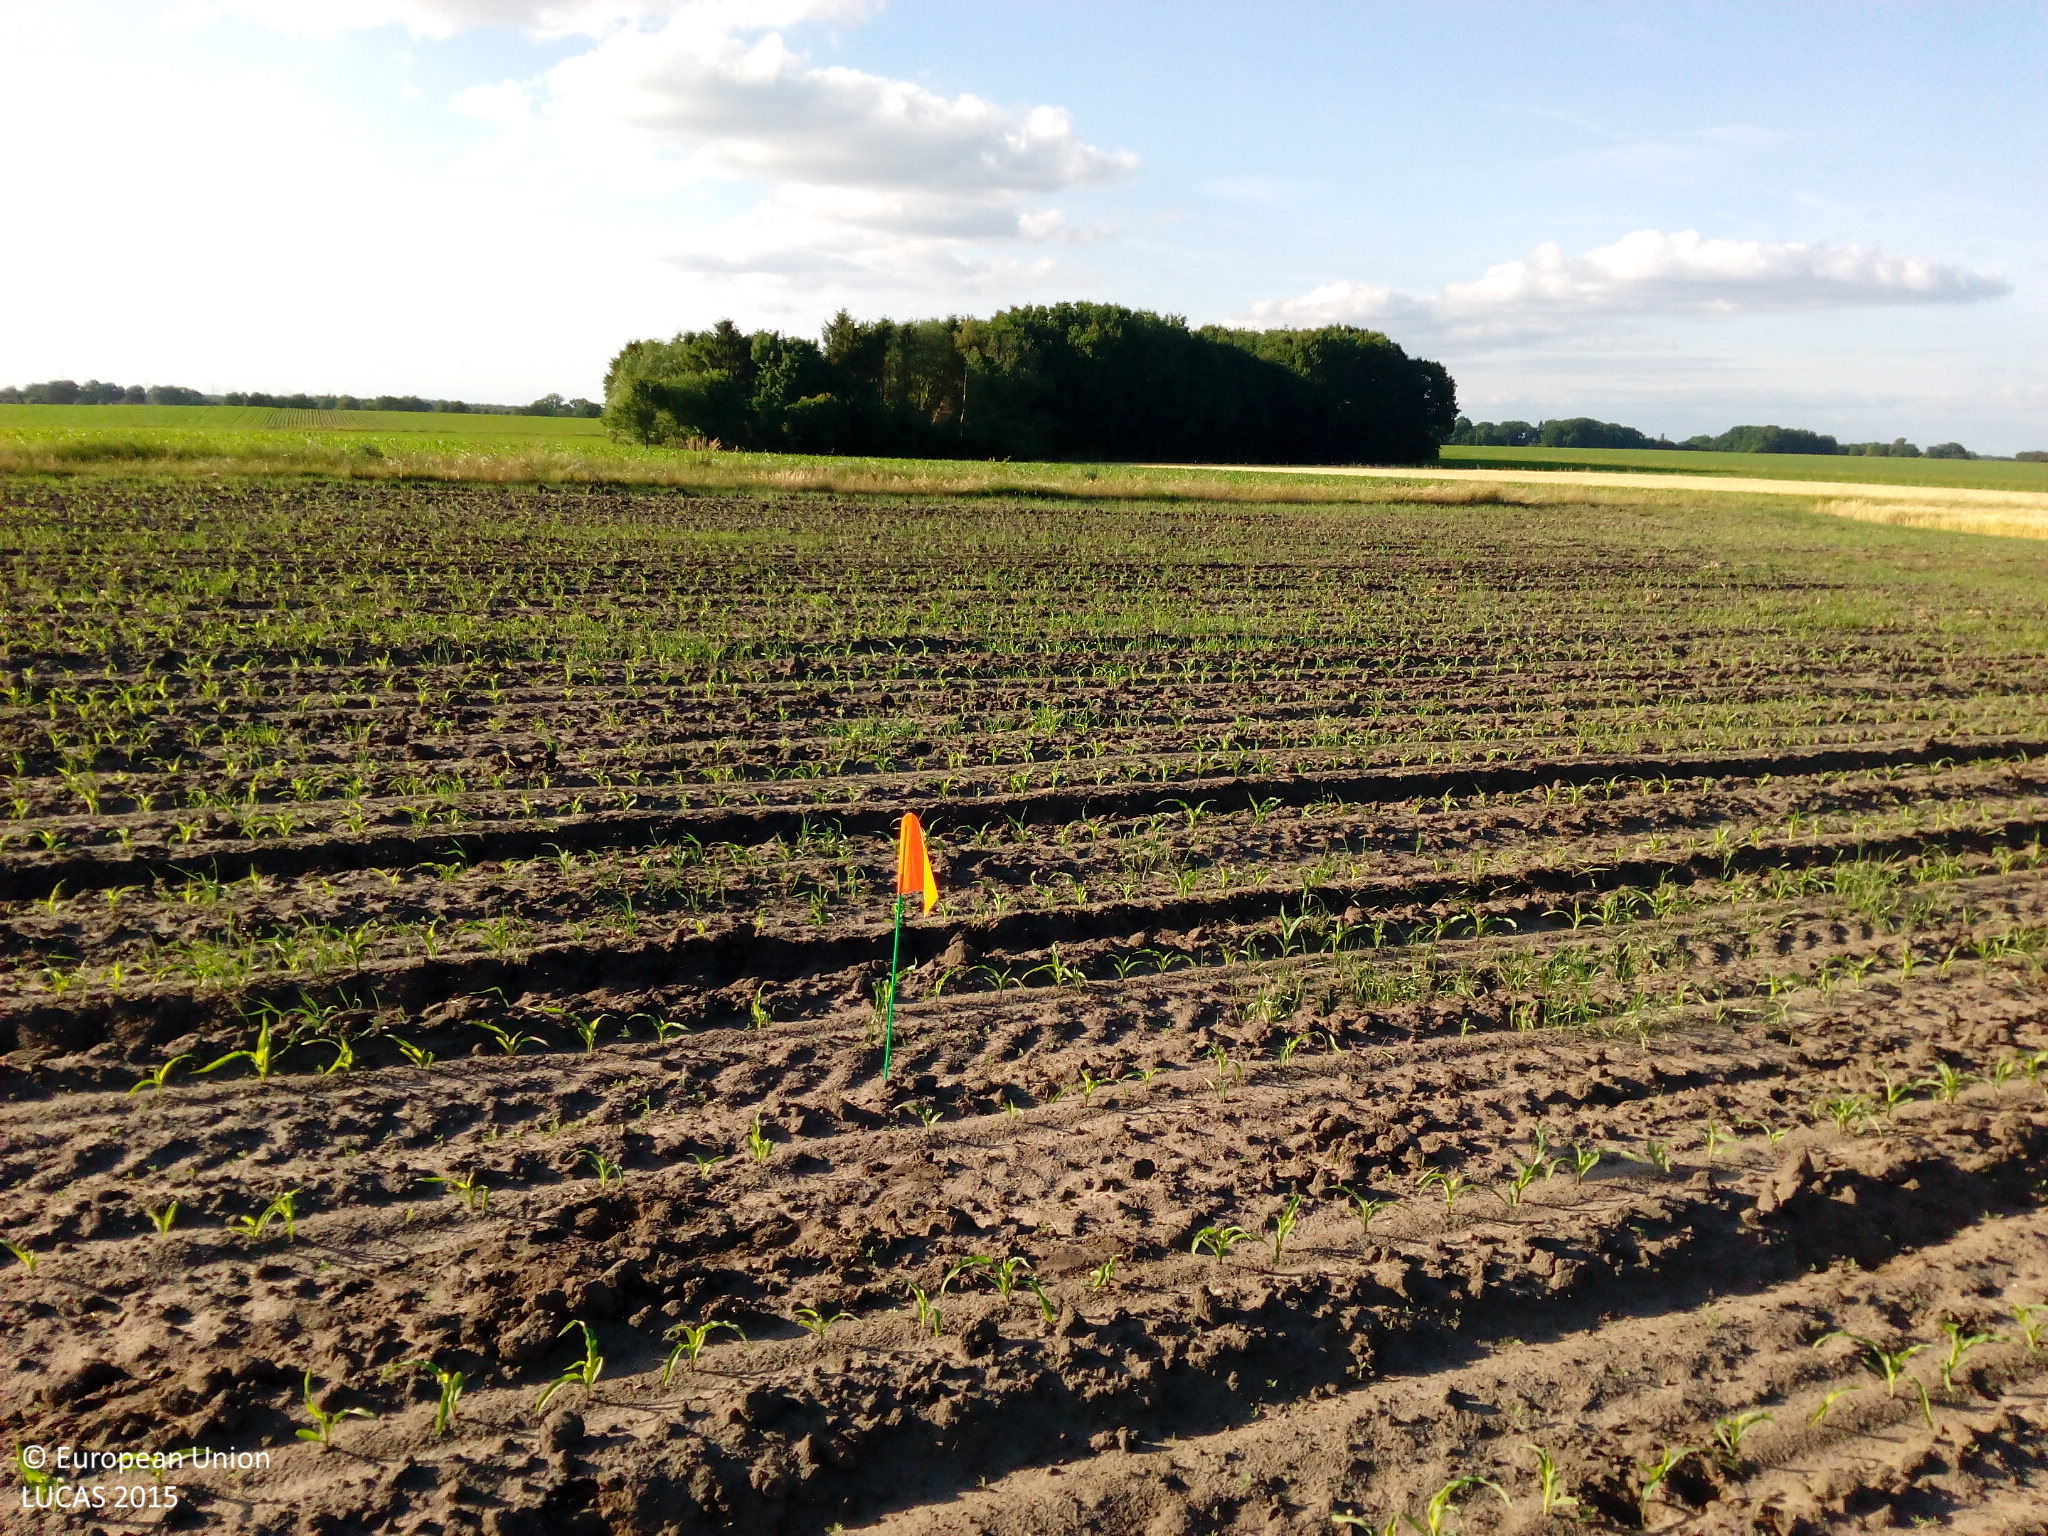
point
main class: Cropland
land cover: Maize
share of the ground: < 10 %
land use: Agriculture (excluding fallow land and kitchen gardens)
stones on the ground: < 10 %
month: June
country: DE
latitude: 52.5114
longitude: 7.4218
